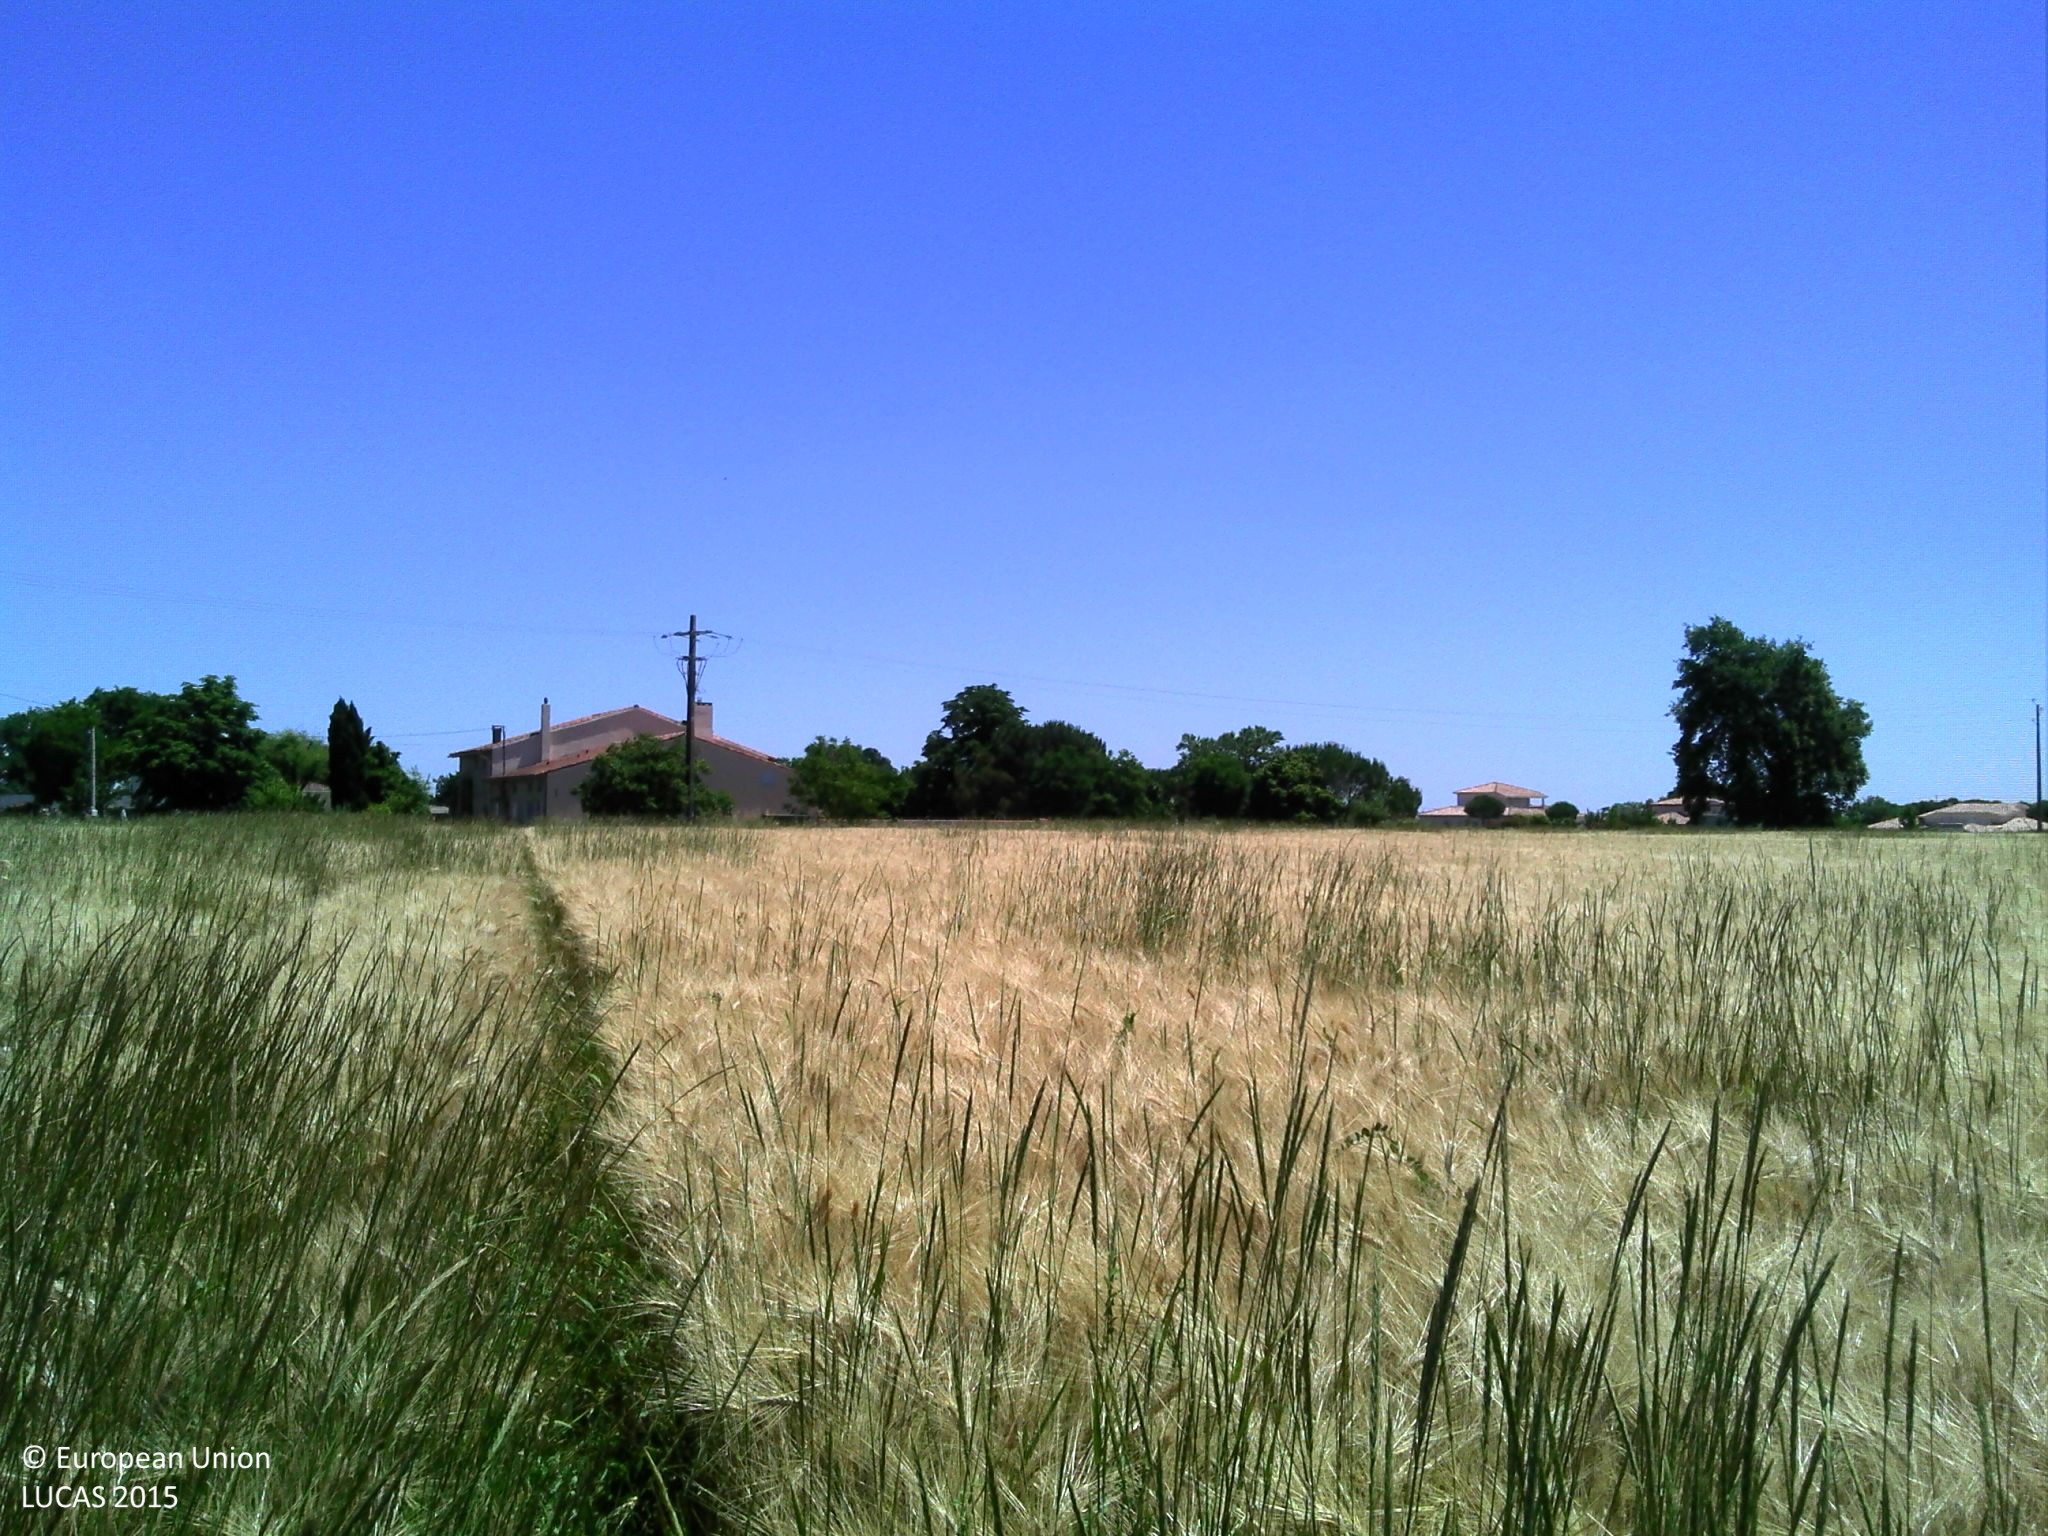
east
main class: Cropland
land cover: Barley
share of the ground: > 75 %
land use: Agriculture (excluding fallow land and kitchen gardens)
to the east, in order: Barley; Electric lines; Grass margins; Tracks; Artificial constructions in urban areas; Grassland without tree/shrub cover; Artificial constructions in urban areas; Fences; Grassland without tree/shrub cover
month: June
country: FR
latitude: 43.7127
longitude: 1.3011
